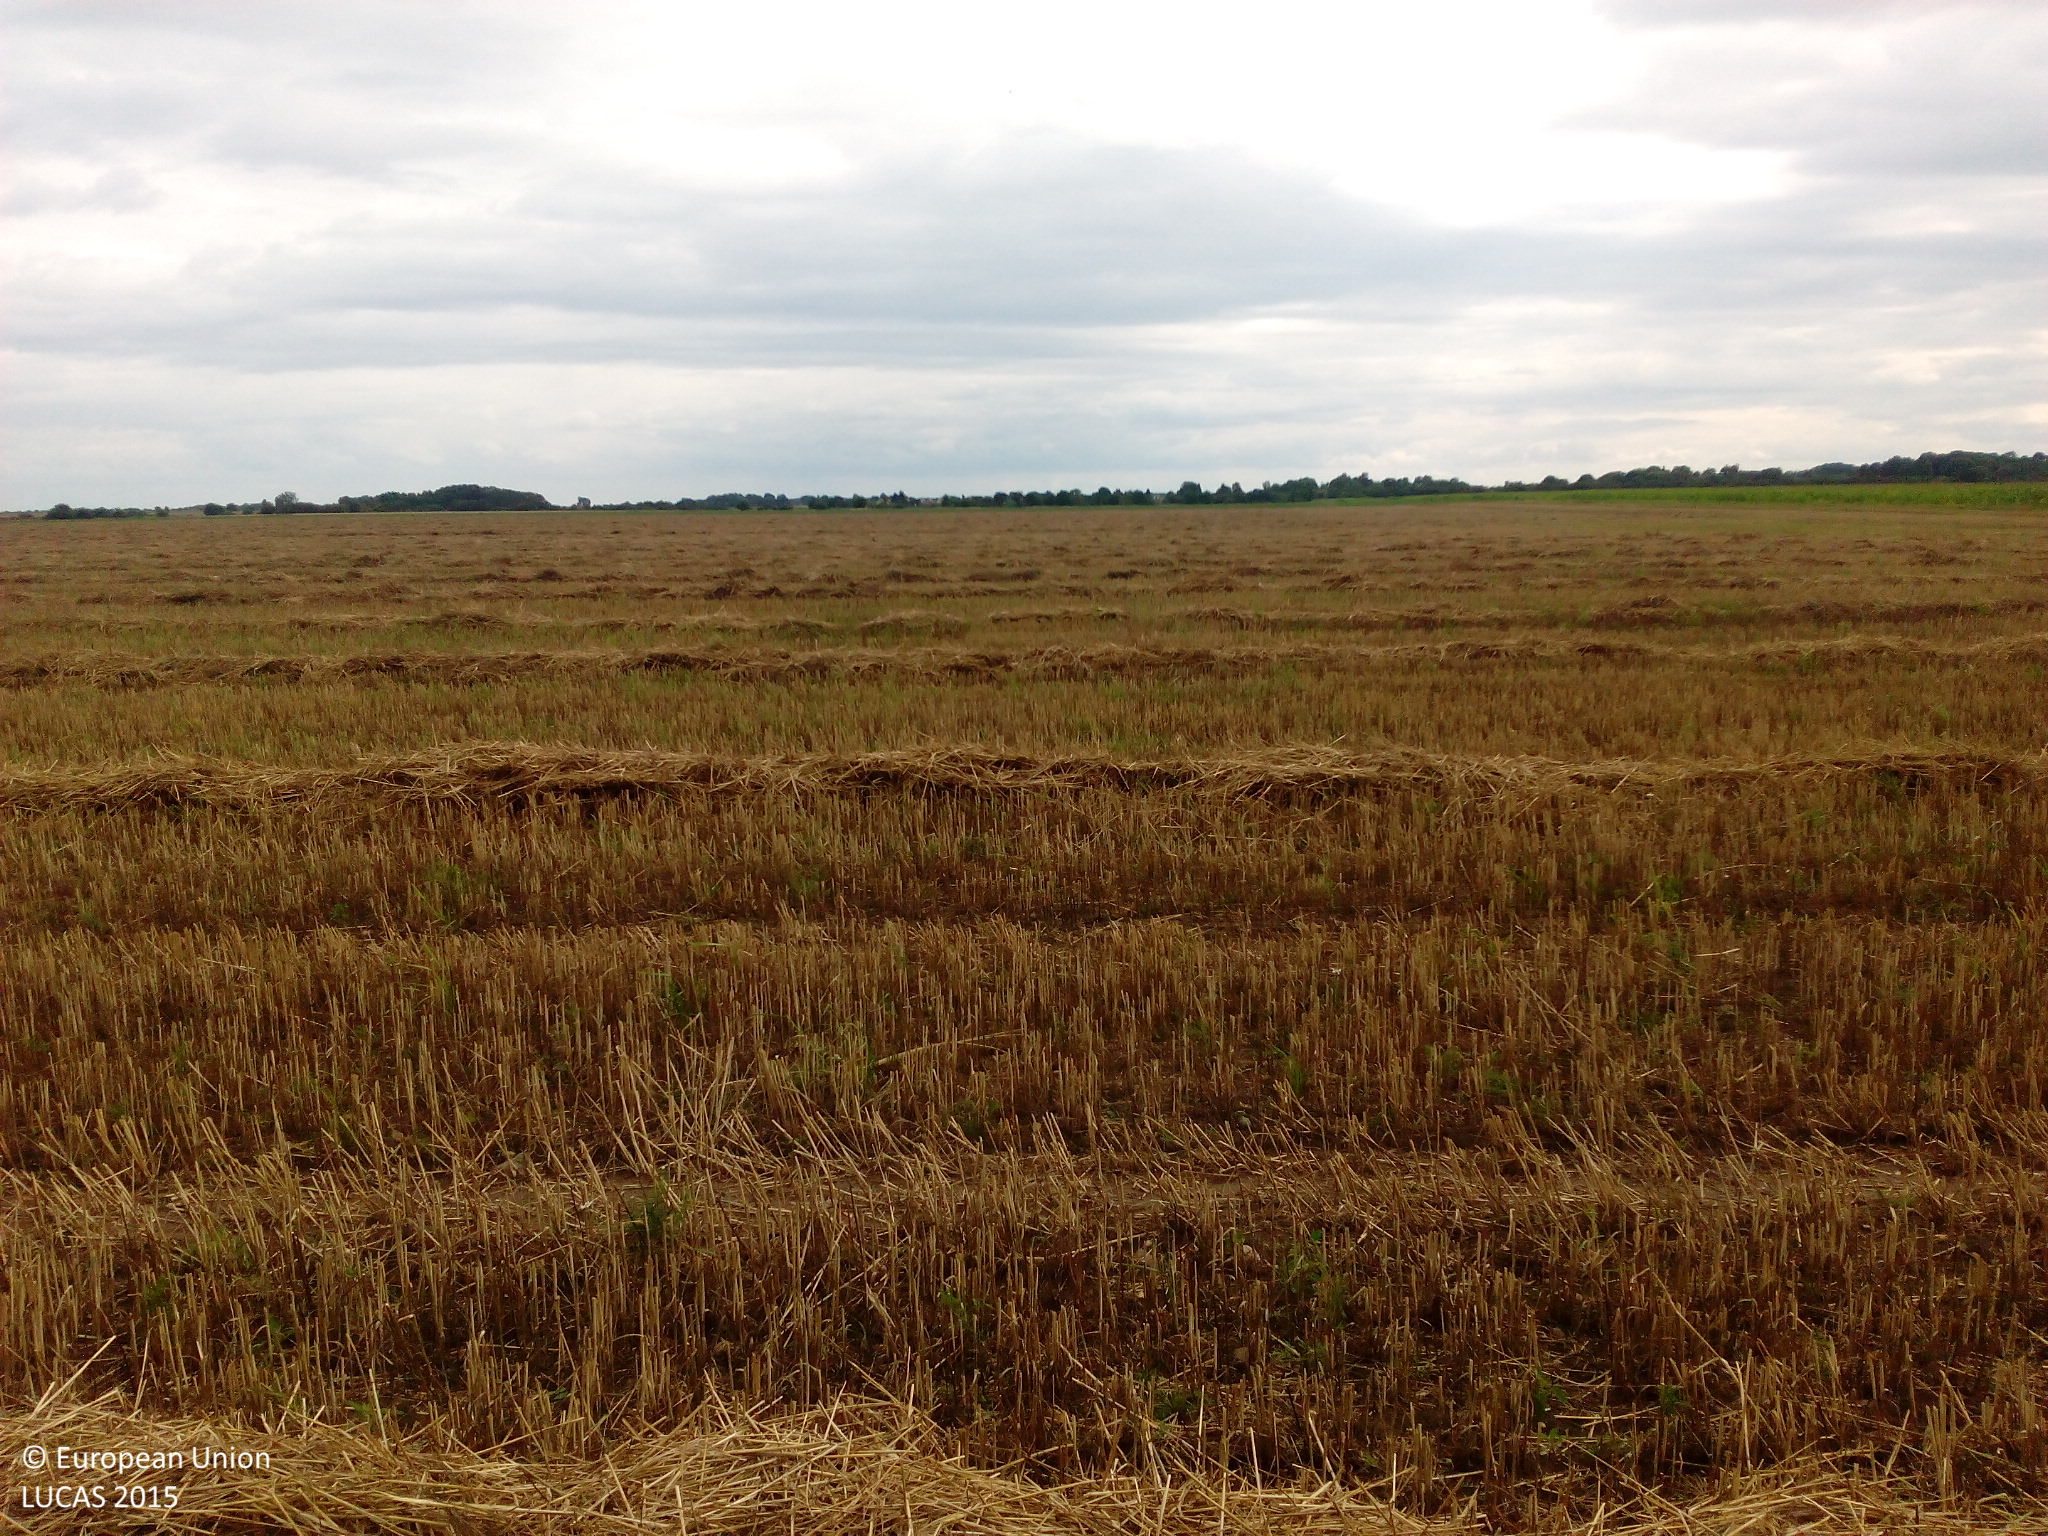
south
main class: Cropland
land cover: Common wheat
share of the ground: 10 - 25 %
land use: Agriculture (excluding fallow land and kitchen gardens)
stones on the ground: < 10 %
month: July
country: DE
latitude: 52.1084
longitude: 12.0291
